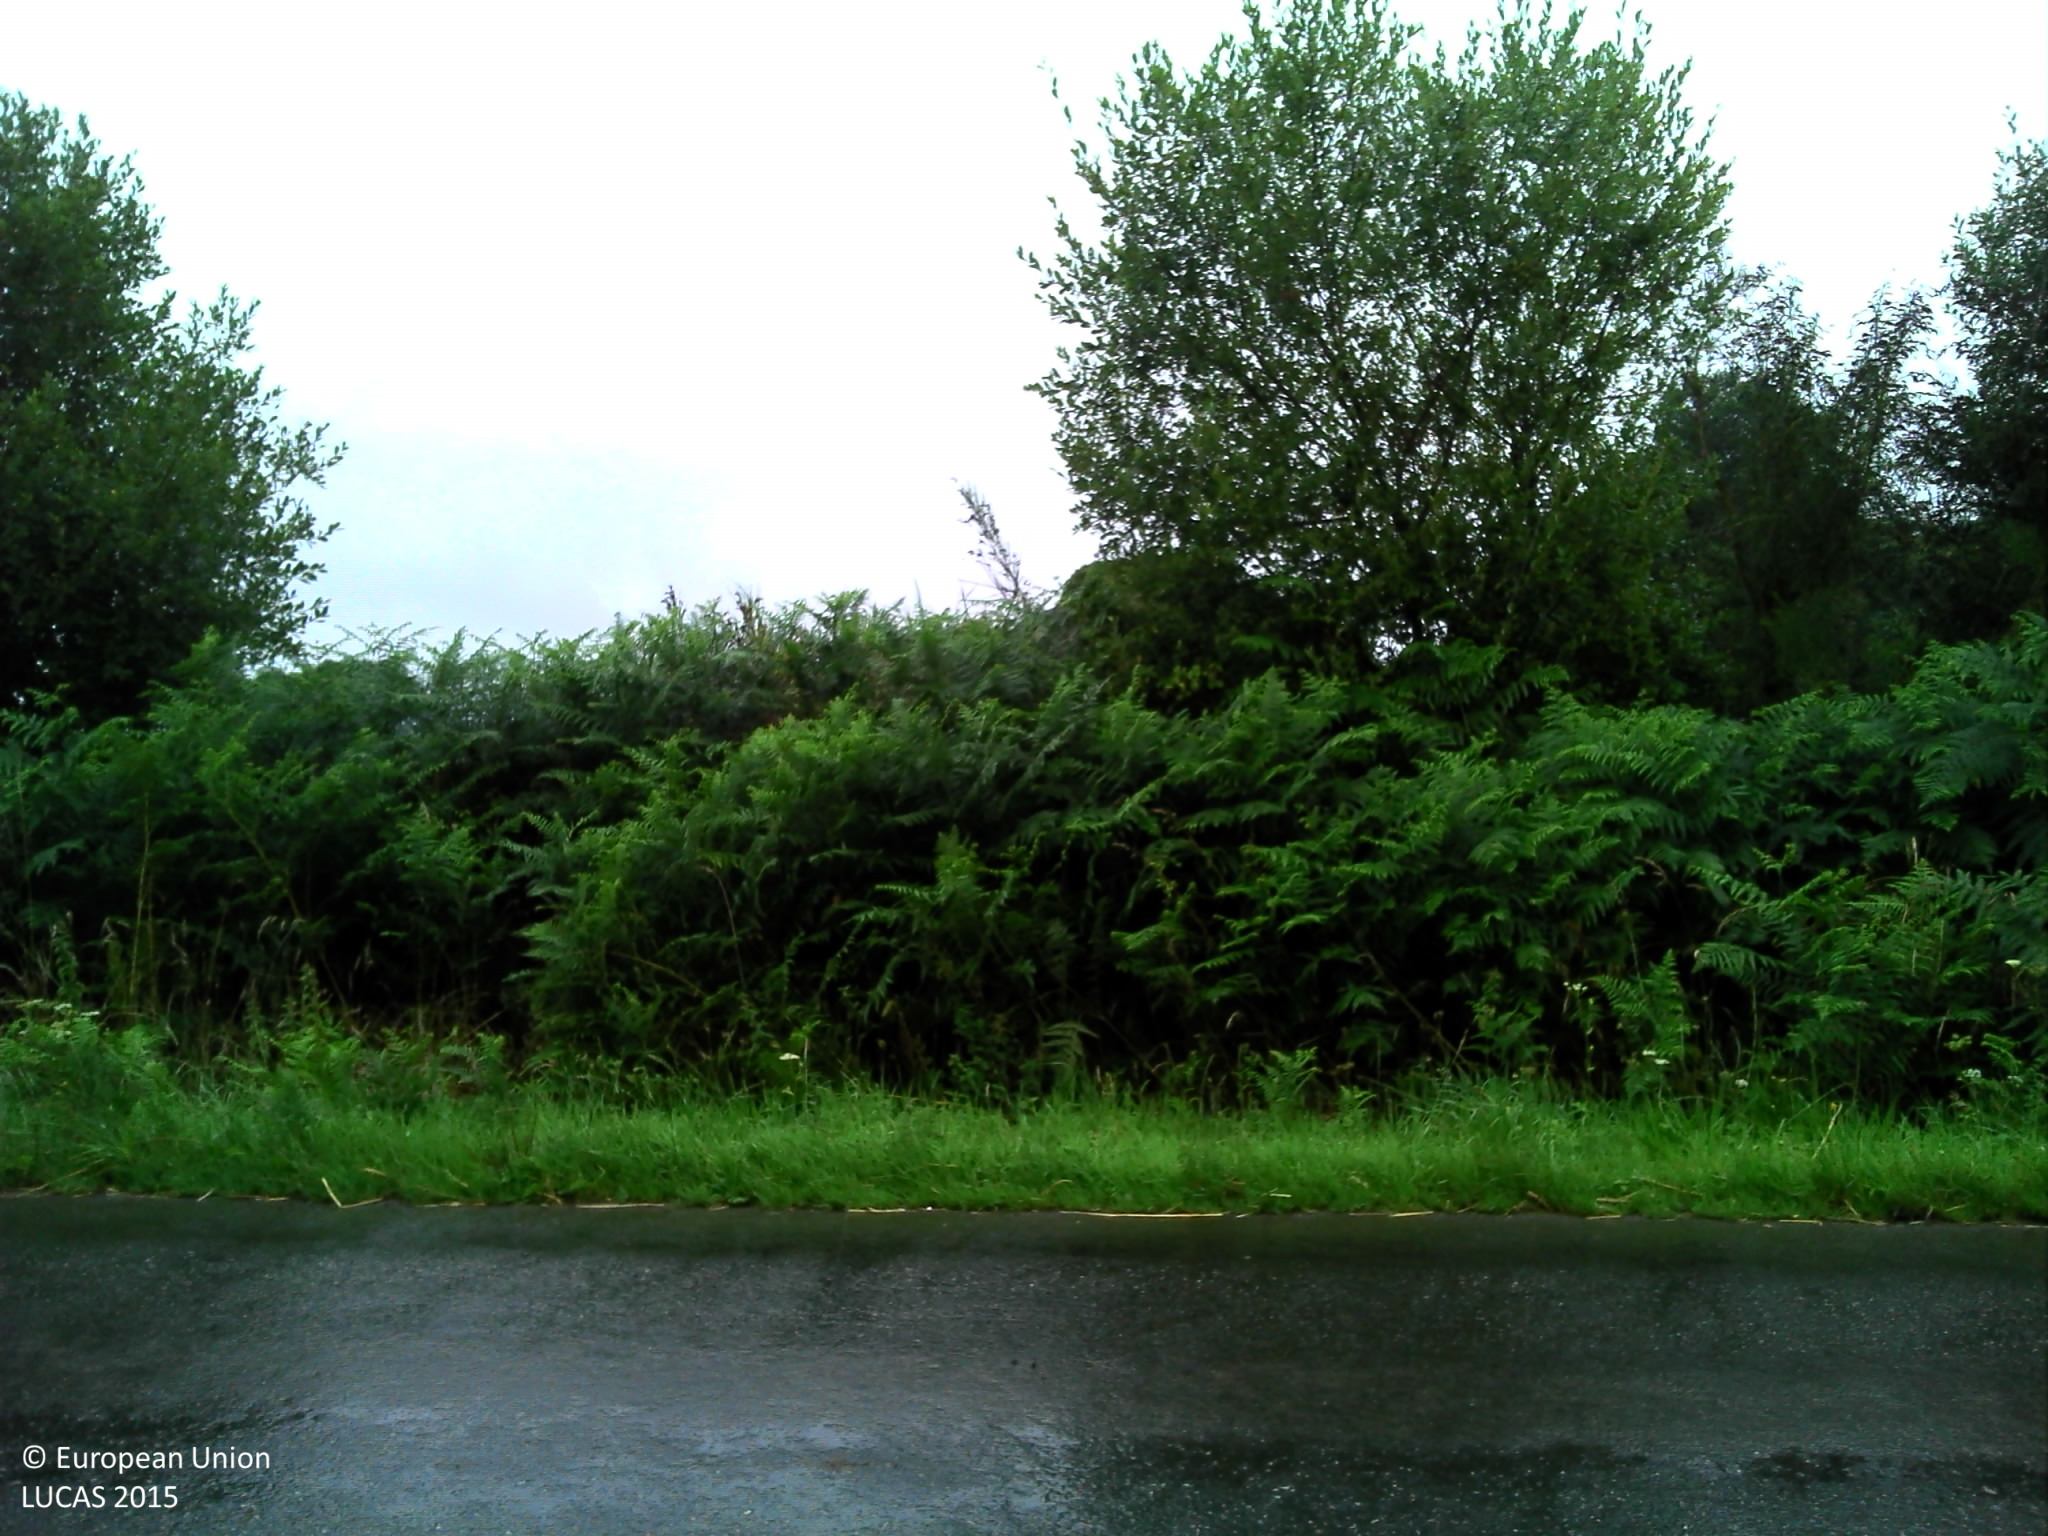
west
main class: Shrubland
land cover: Shrubland with sparse tree cover
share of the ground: > 75 %
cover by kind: shrubs 95 %, broadleaved forest trees 5 %
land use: Forestry
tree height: > 5 m
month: July
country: FR
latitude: 48.2248
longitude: -3.2242
